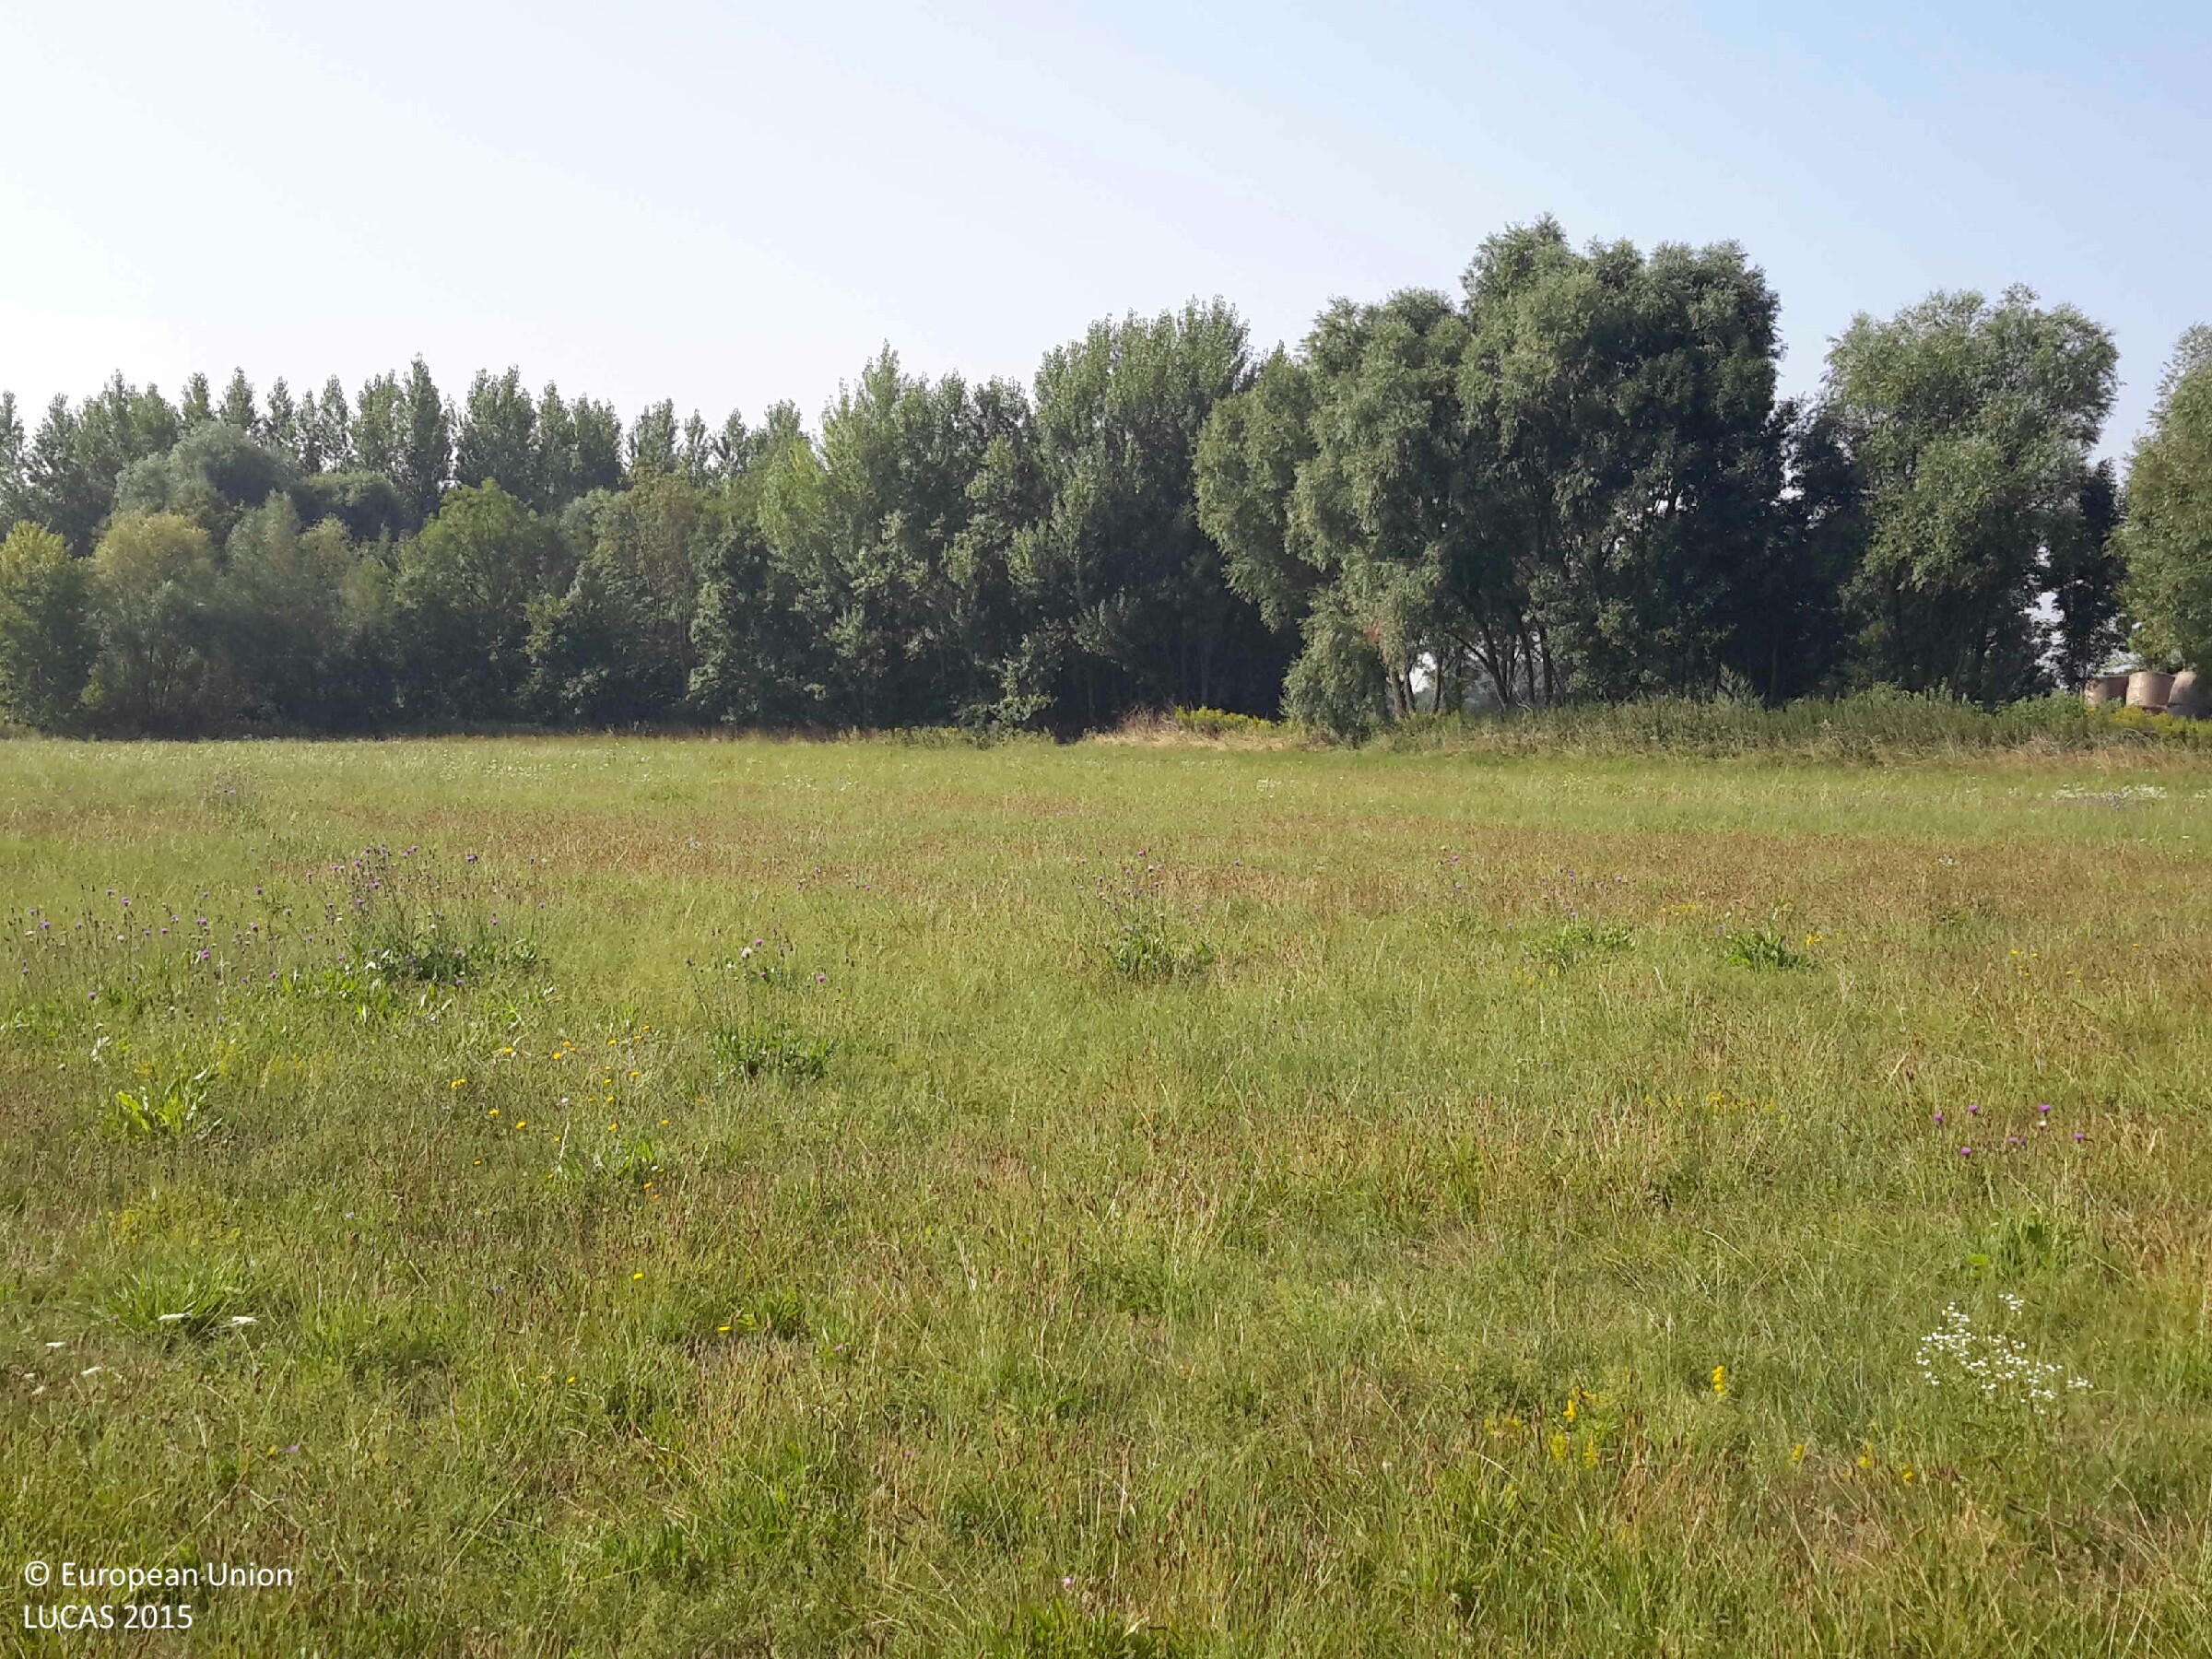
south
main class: Grassland
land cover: Grassland without tree/shrub cover
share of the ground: > 75 %
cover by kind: herbaceous plants 100 %
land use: Agriculture (excluding fallow land and kitchen gardens)
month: August
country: HU
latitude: 47.6961
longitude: 17.2427
